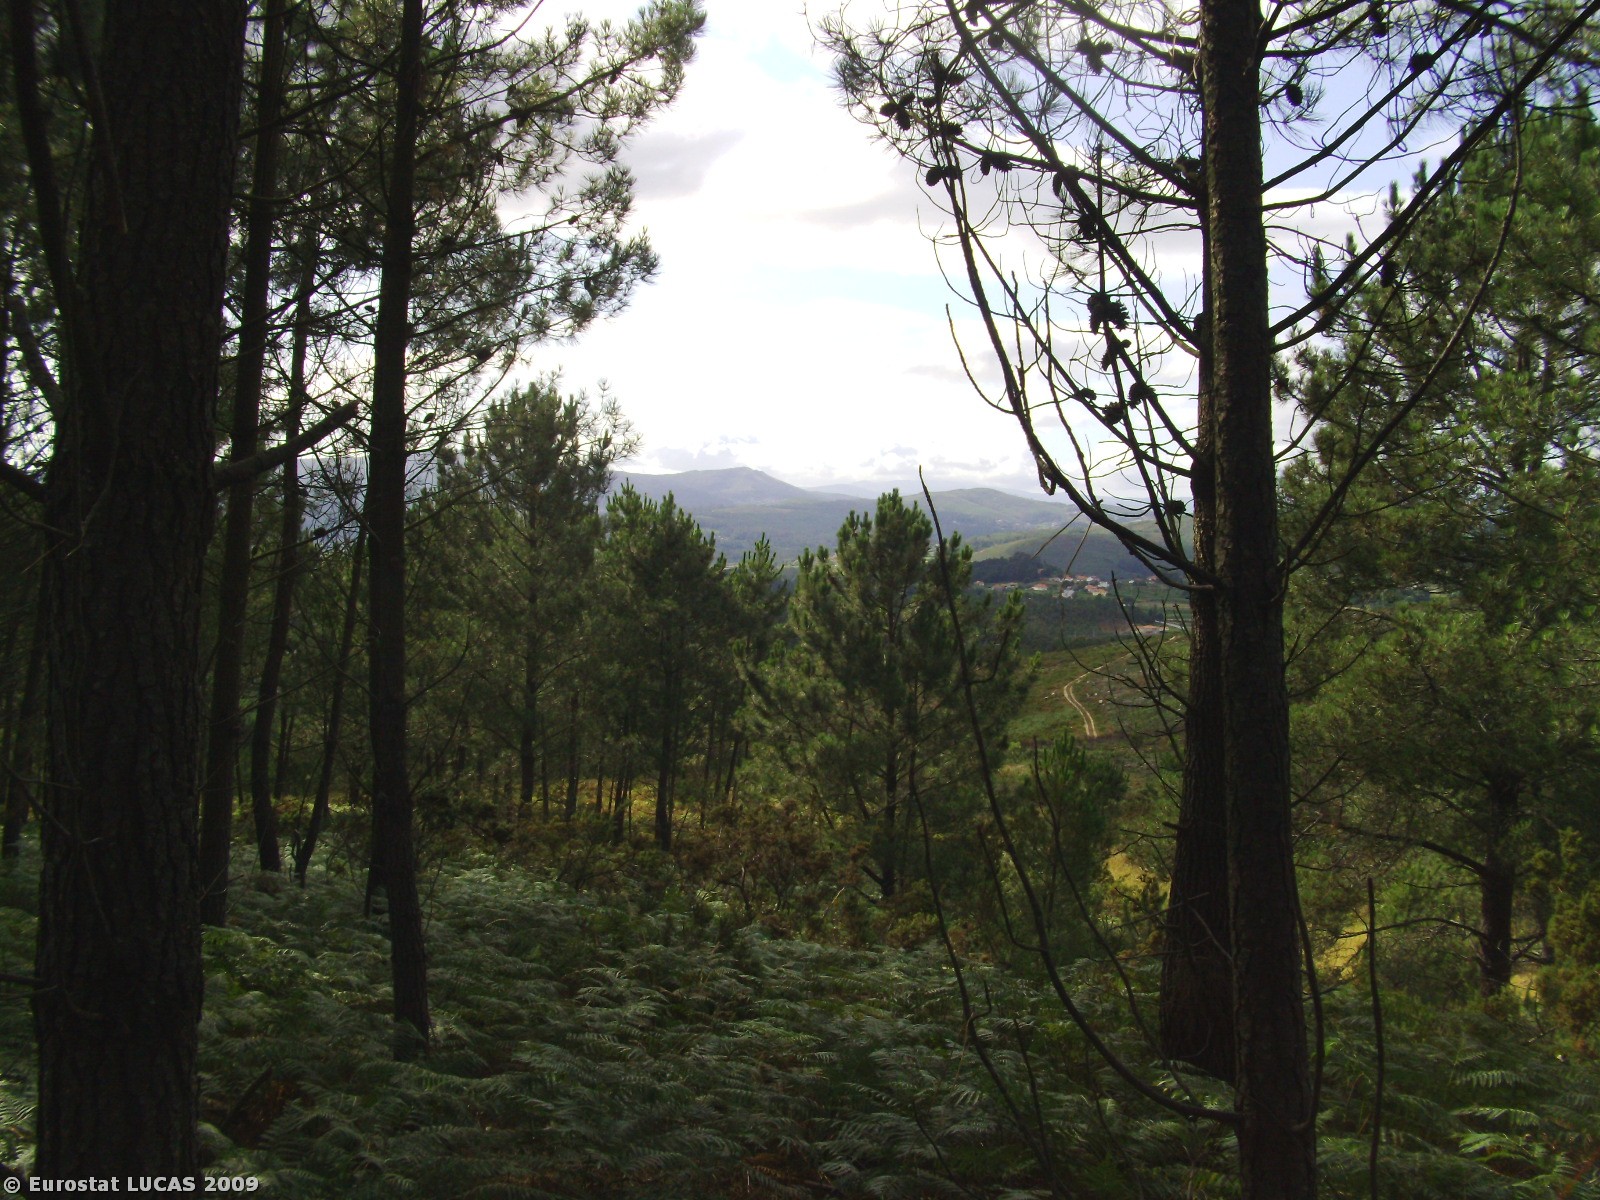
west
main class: Woodland
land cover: Coniferous woodland
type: coniferous forest of the mediterranean region
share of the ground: > 75 %
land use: Forestry
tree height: > 5 m
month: July
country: PT
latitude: 41.8722
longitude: -8.6113
